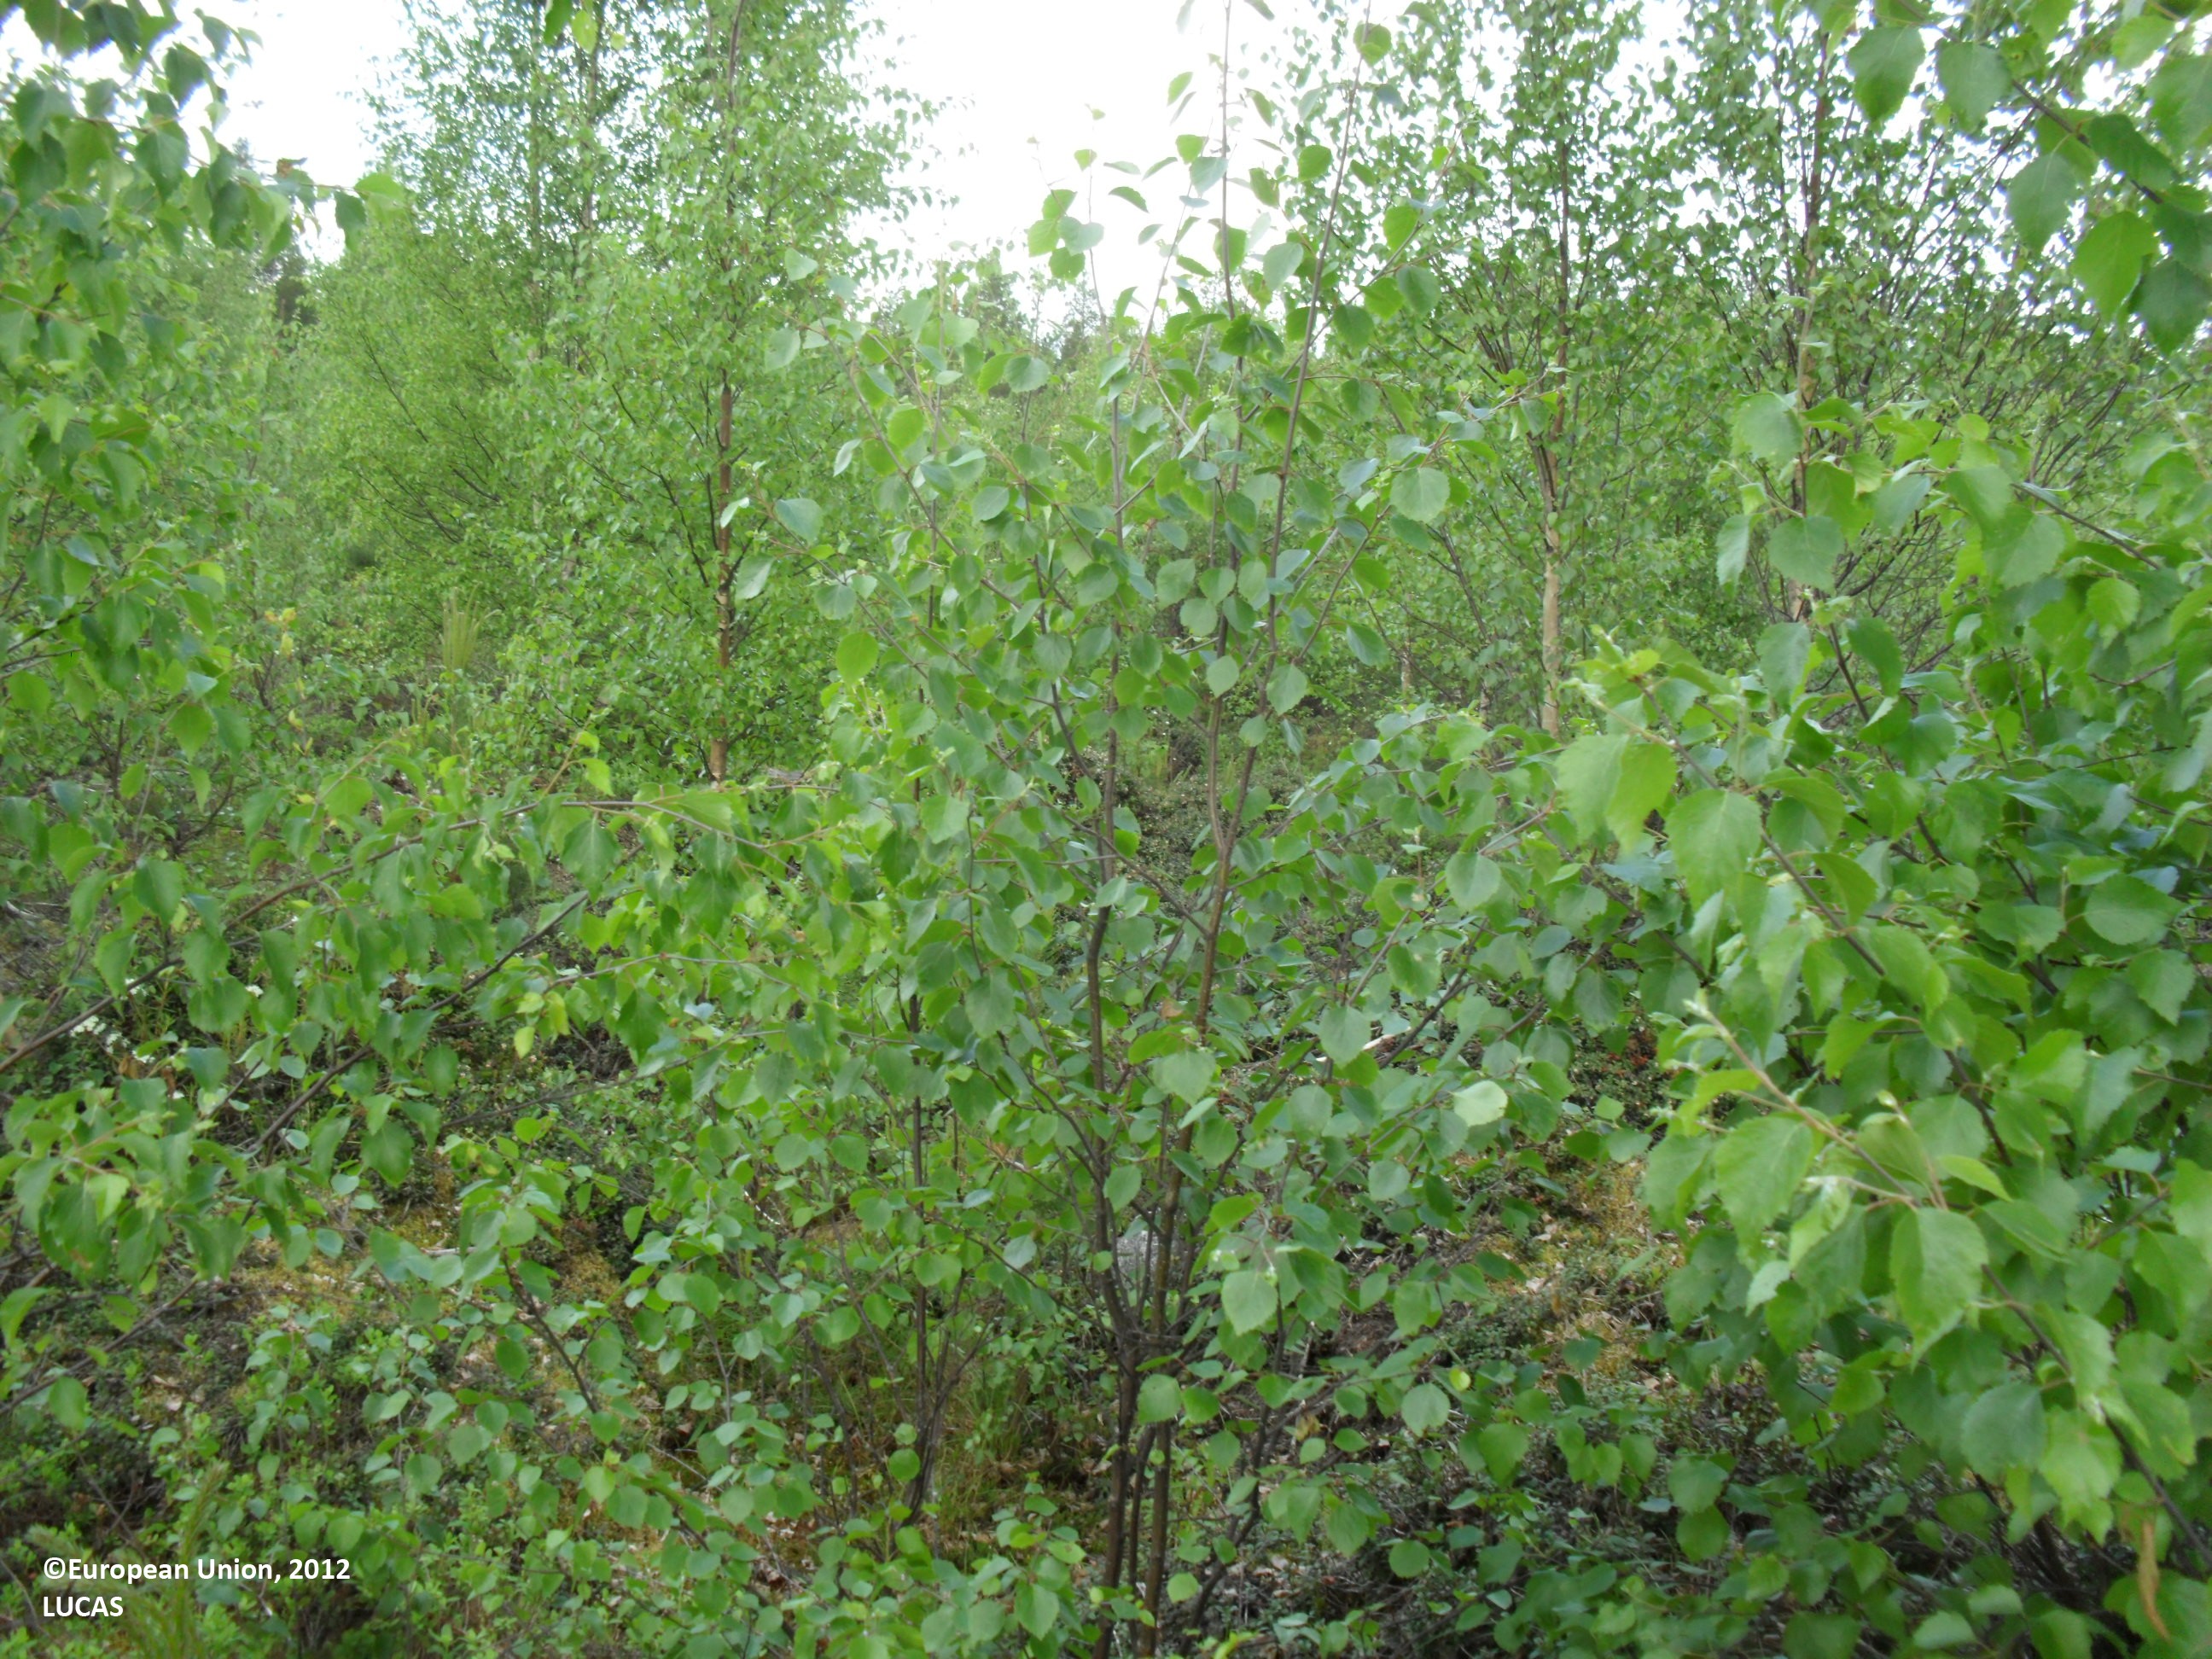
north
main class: Woodland
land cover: Other mixed woodland
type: boreal forest
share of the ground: 10 - 25 %
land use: Forestry
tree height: < 5 m
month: June
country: FI
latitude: 63.2225
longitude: 23.1702
